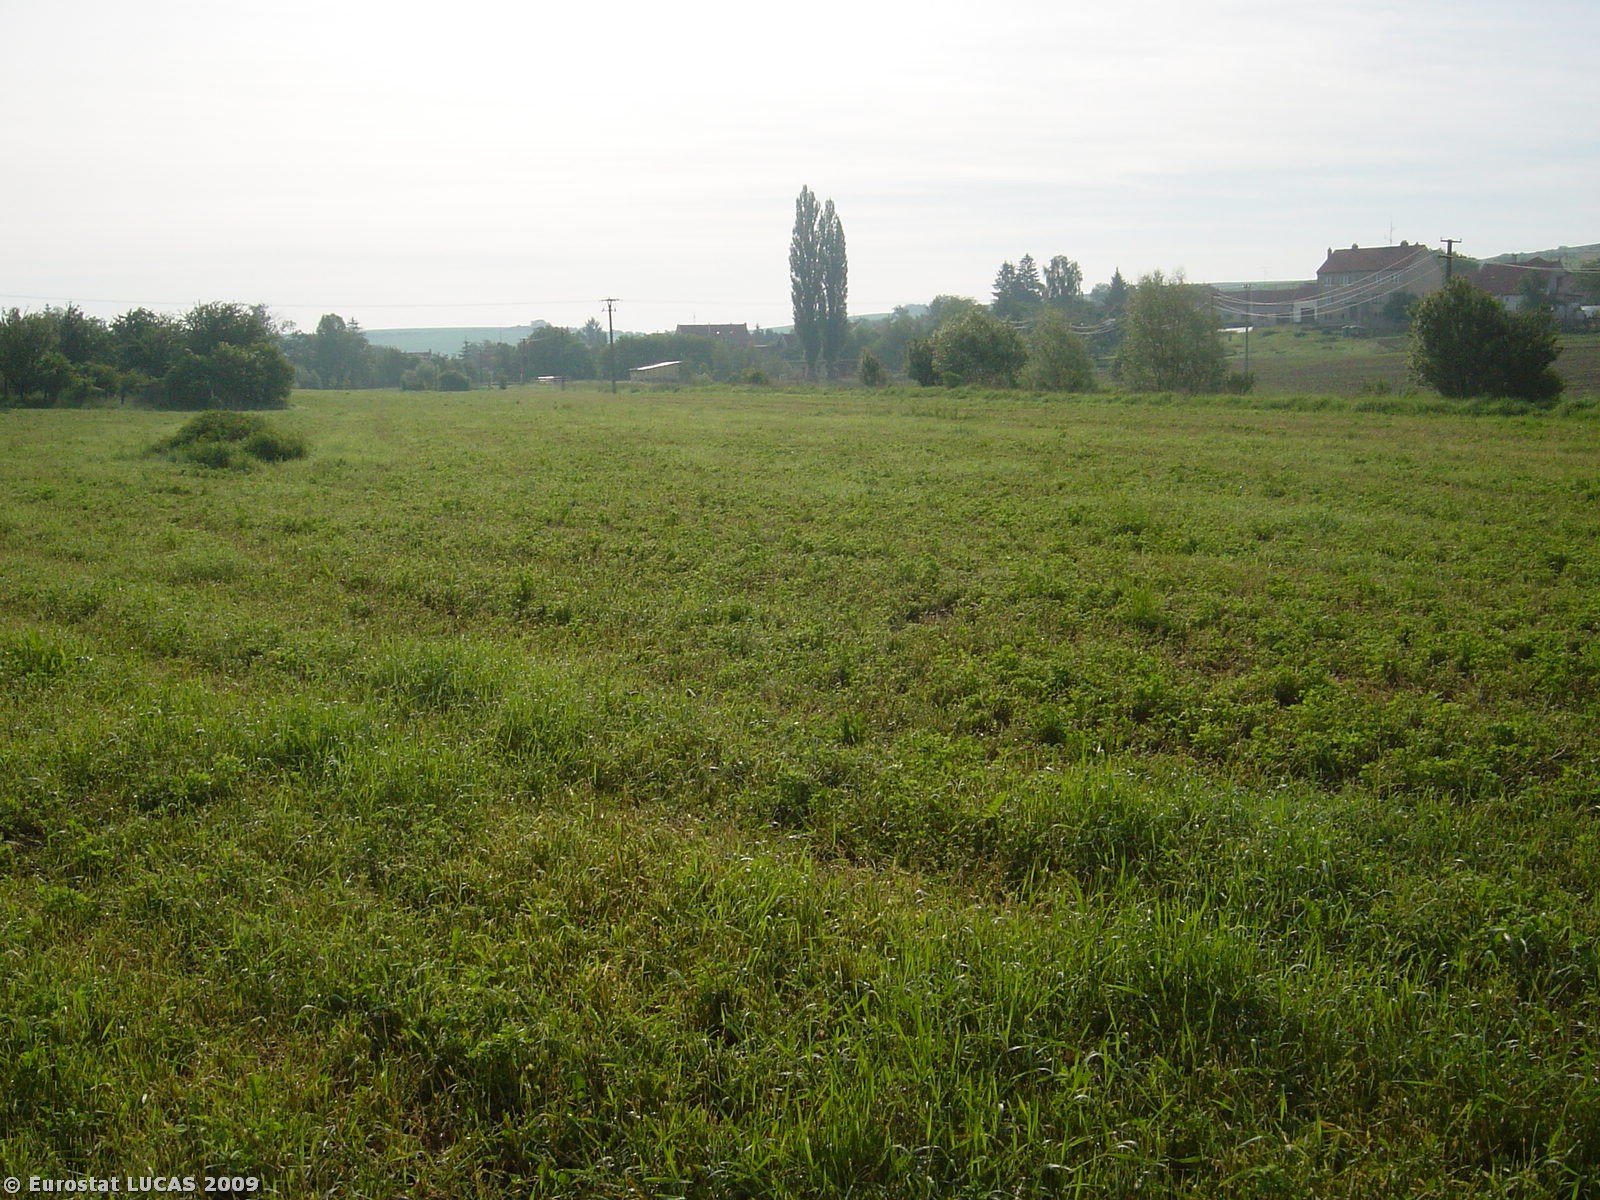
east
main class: Cropland
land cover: Lucerne
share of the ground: 25 - 50 %
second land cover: Grassland without tree/shrub cover
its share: > 75 %
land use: Agriculture (excluding fallow land and kitchen gardens)
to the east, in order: Lucerne; Grassland without tree/shrub cover; Electric lines; Fences; Grassland without tree/shrub cover; Rivers and streams; Grassland without tree/shrub cover; Sunflower
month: May
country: CZ
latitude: 49.1701
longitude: 17.0730
